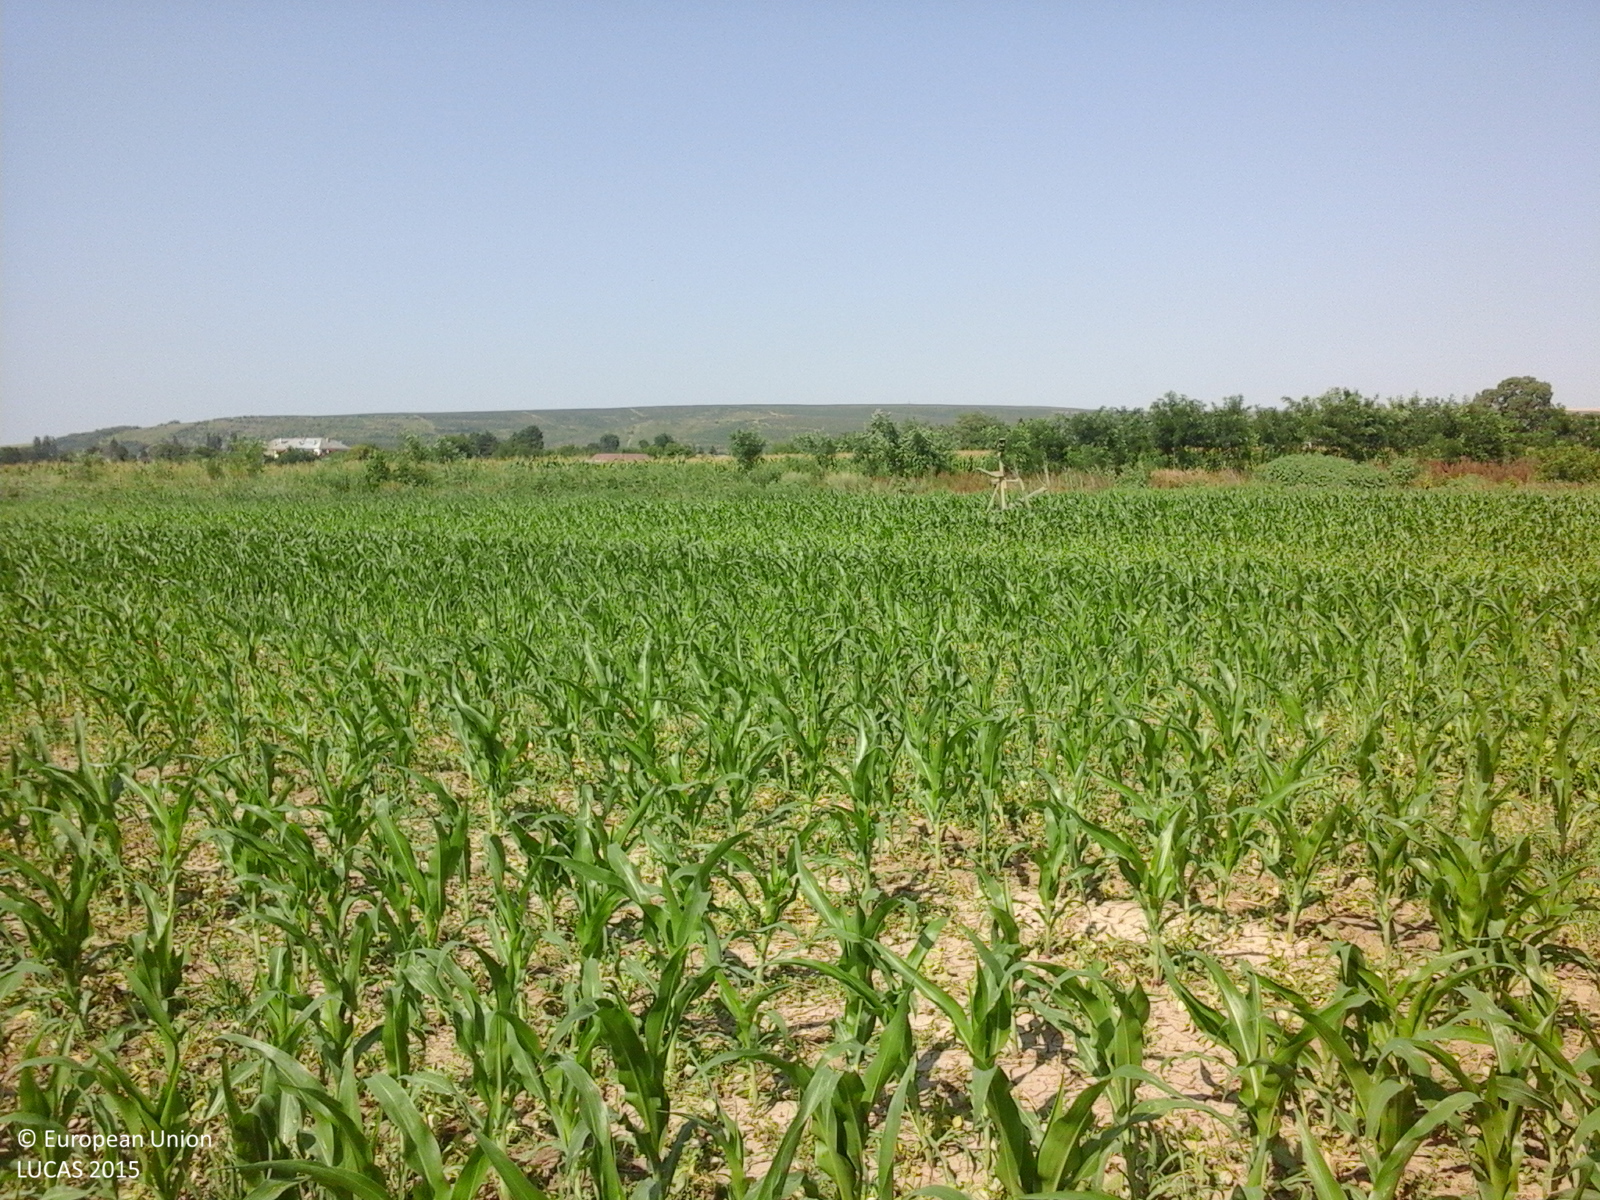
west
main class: Cropland
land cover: Maize
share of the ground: 50 - 75 %
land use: Agriculture (excluding fallow land and kitchen gardens)
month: July
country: RO
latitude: 46.1168
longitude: 27.5652
